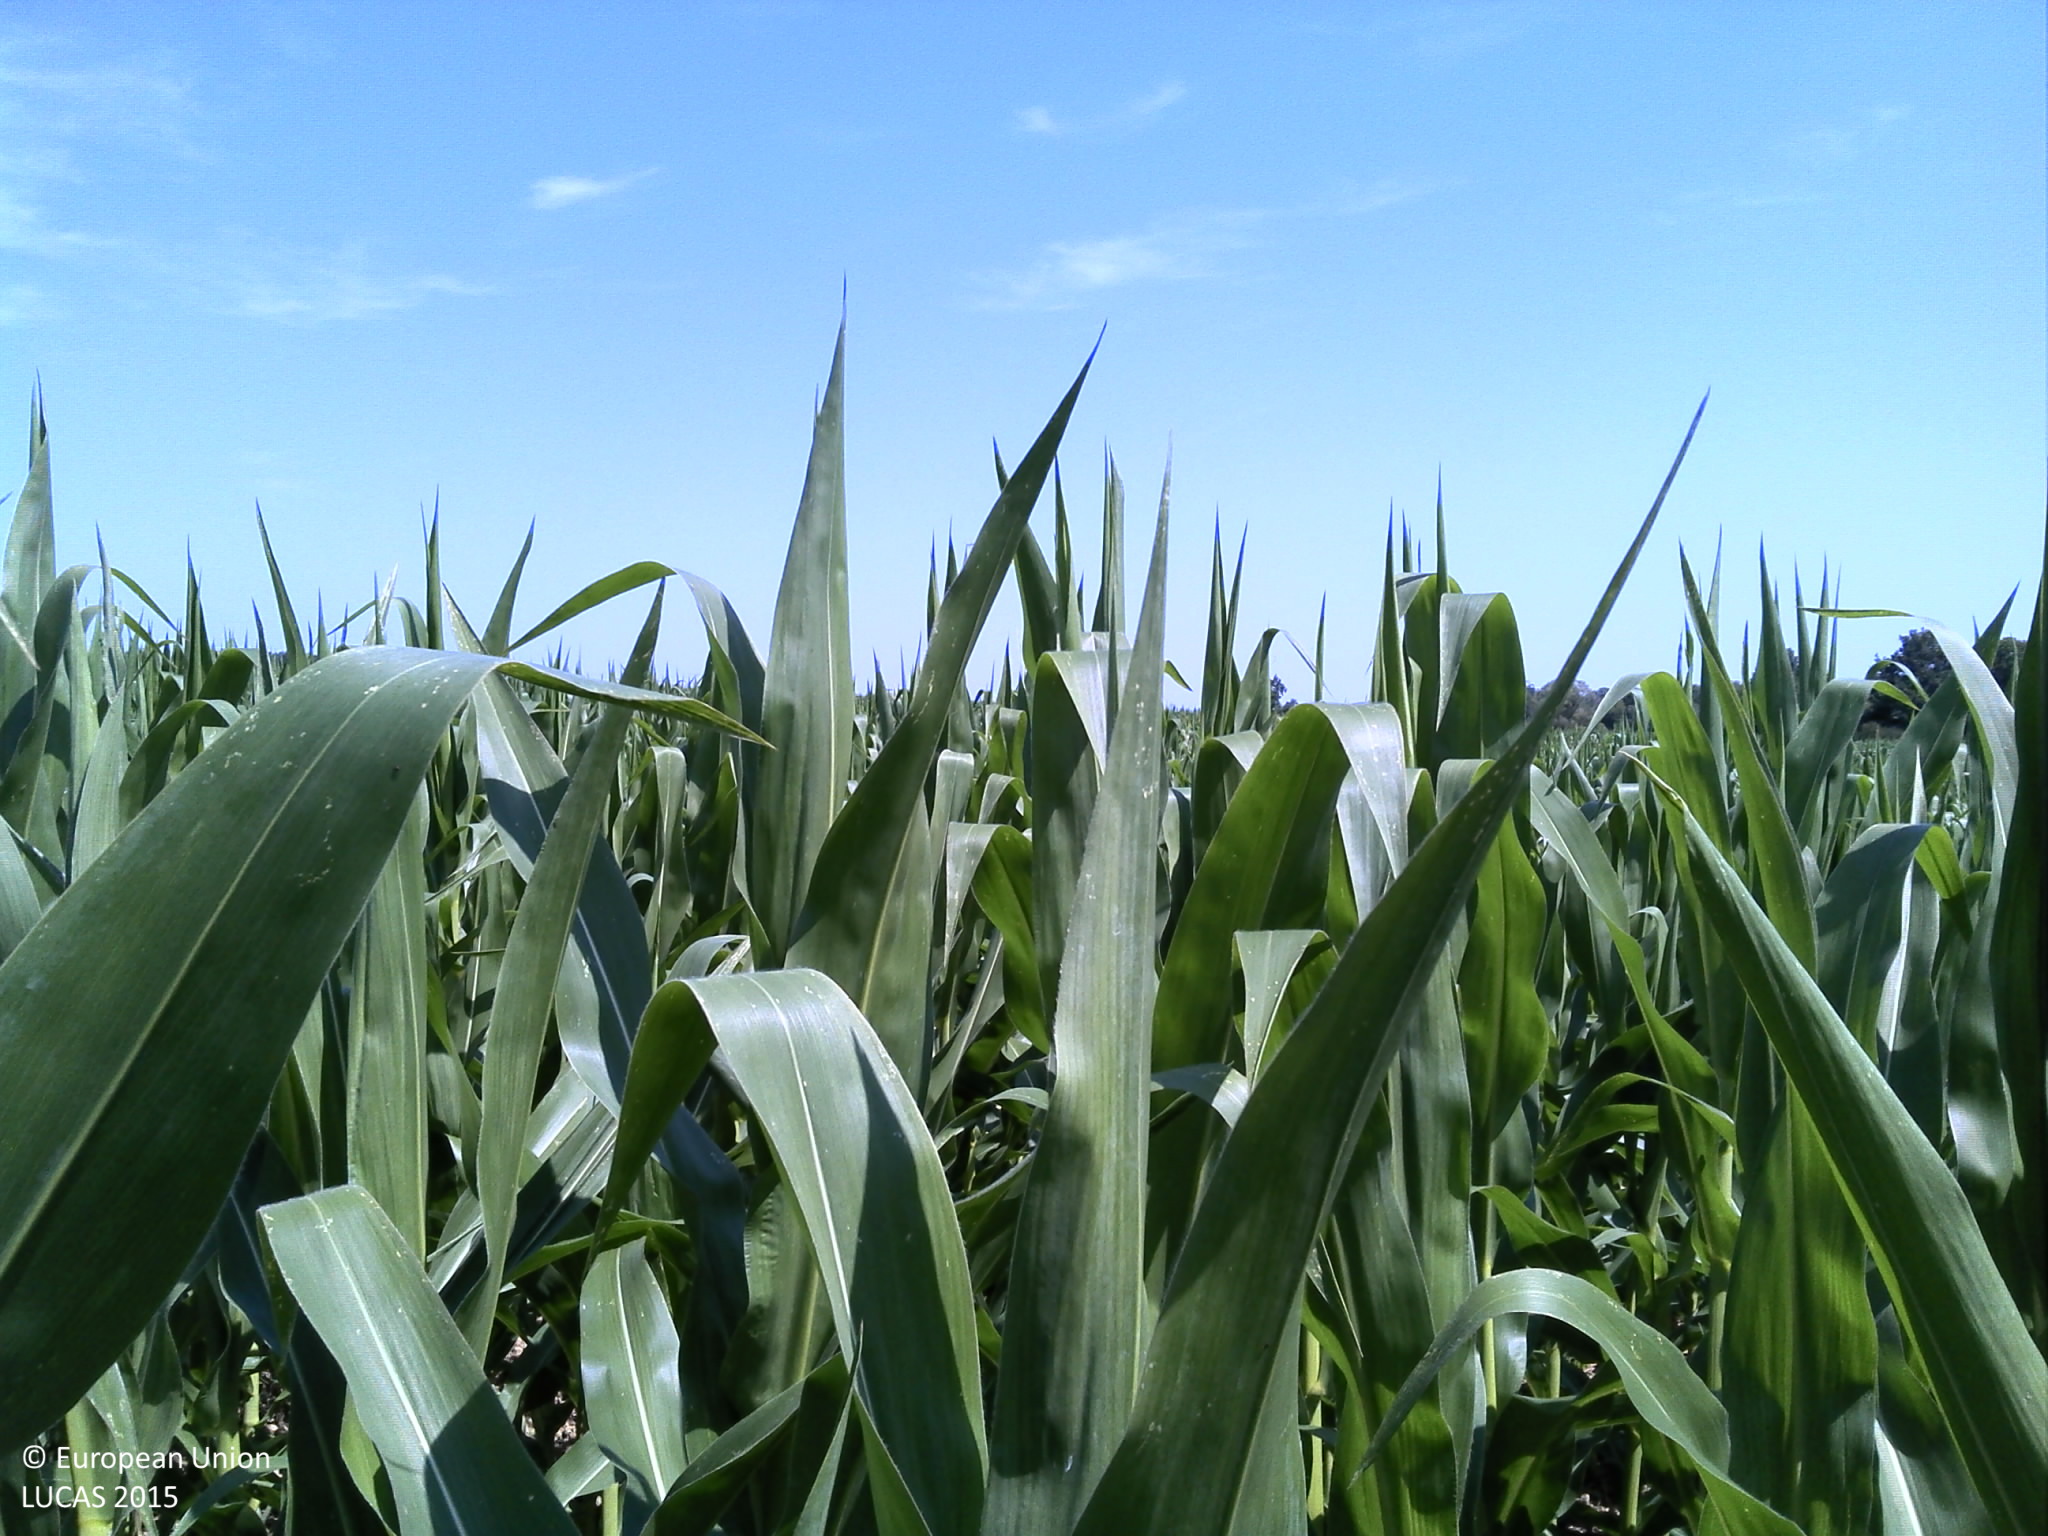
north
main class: Cropland
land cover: Maize
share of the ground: > 75 %
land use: Agriculture (excluding fallow land and kitchen gardens)
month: July
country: HR
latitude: 45.5153
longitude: 16.8735
